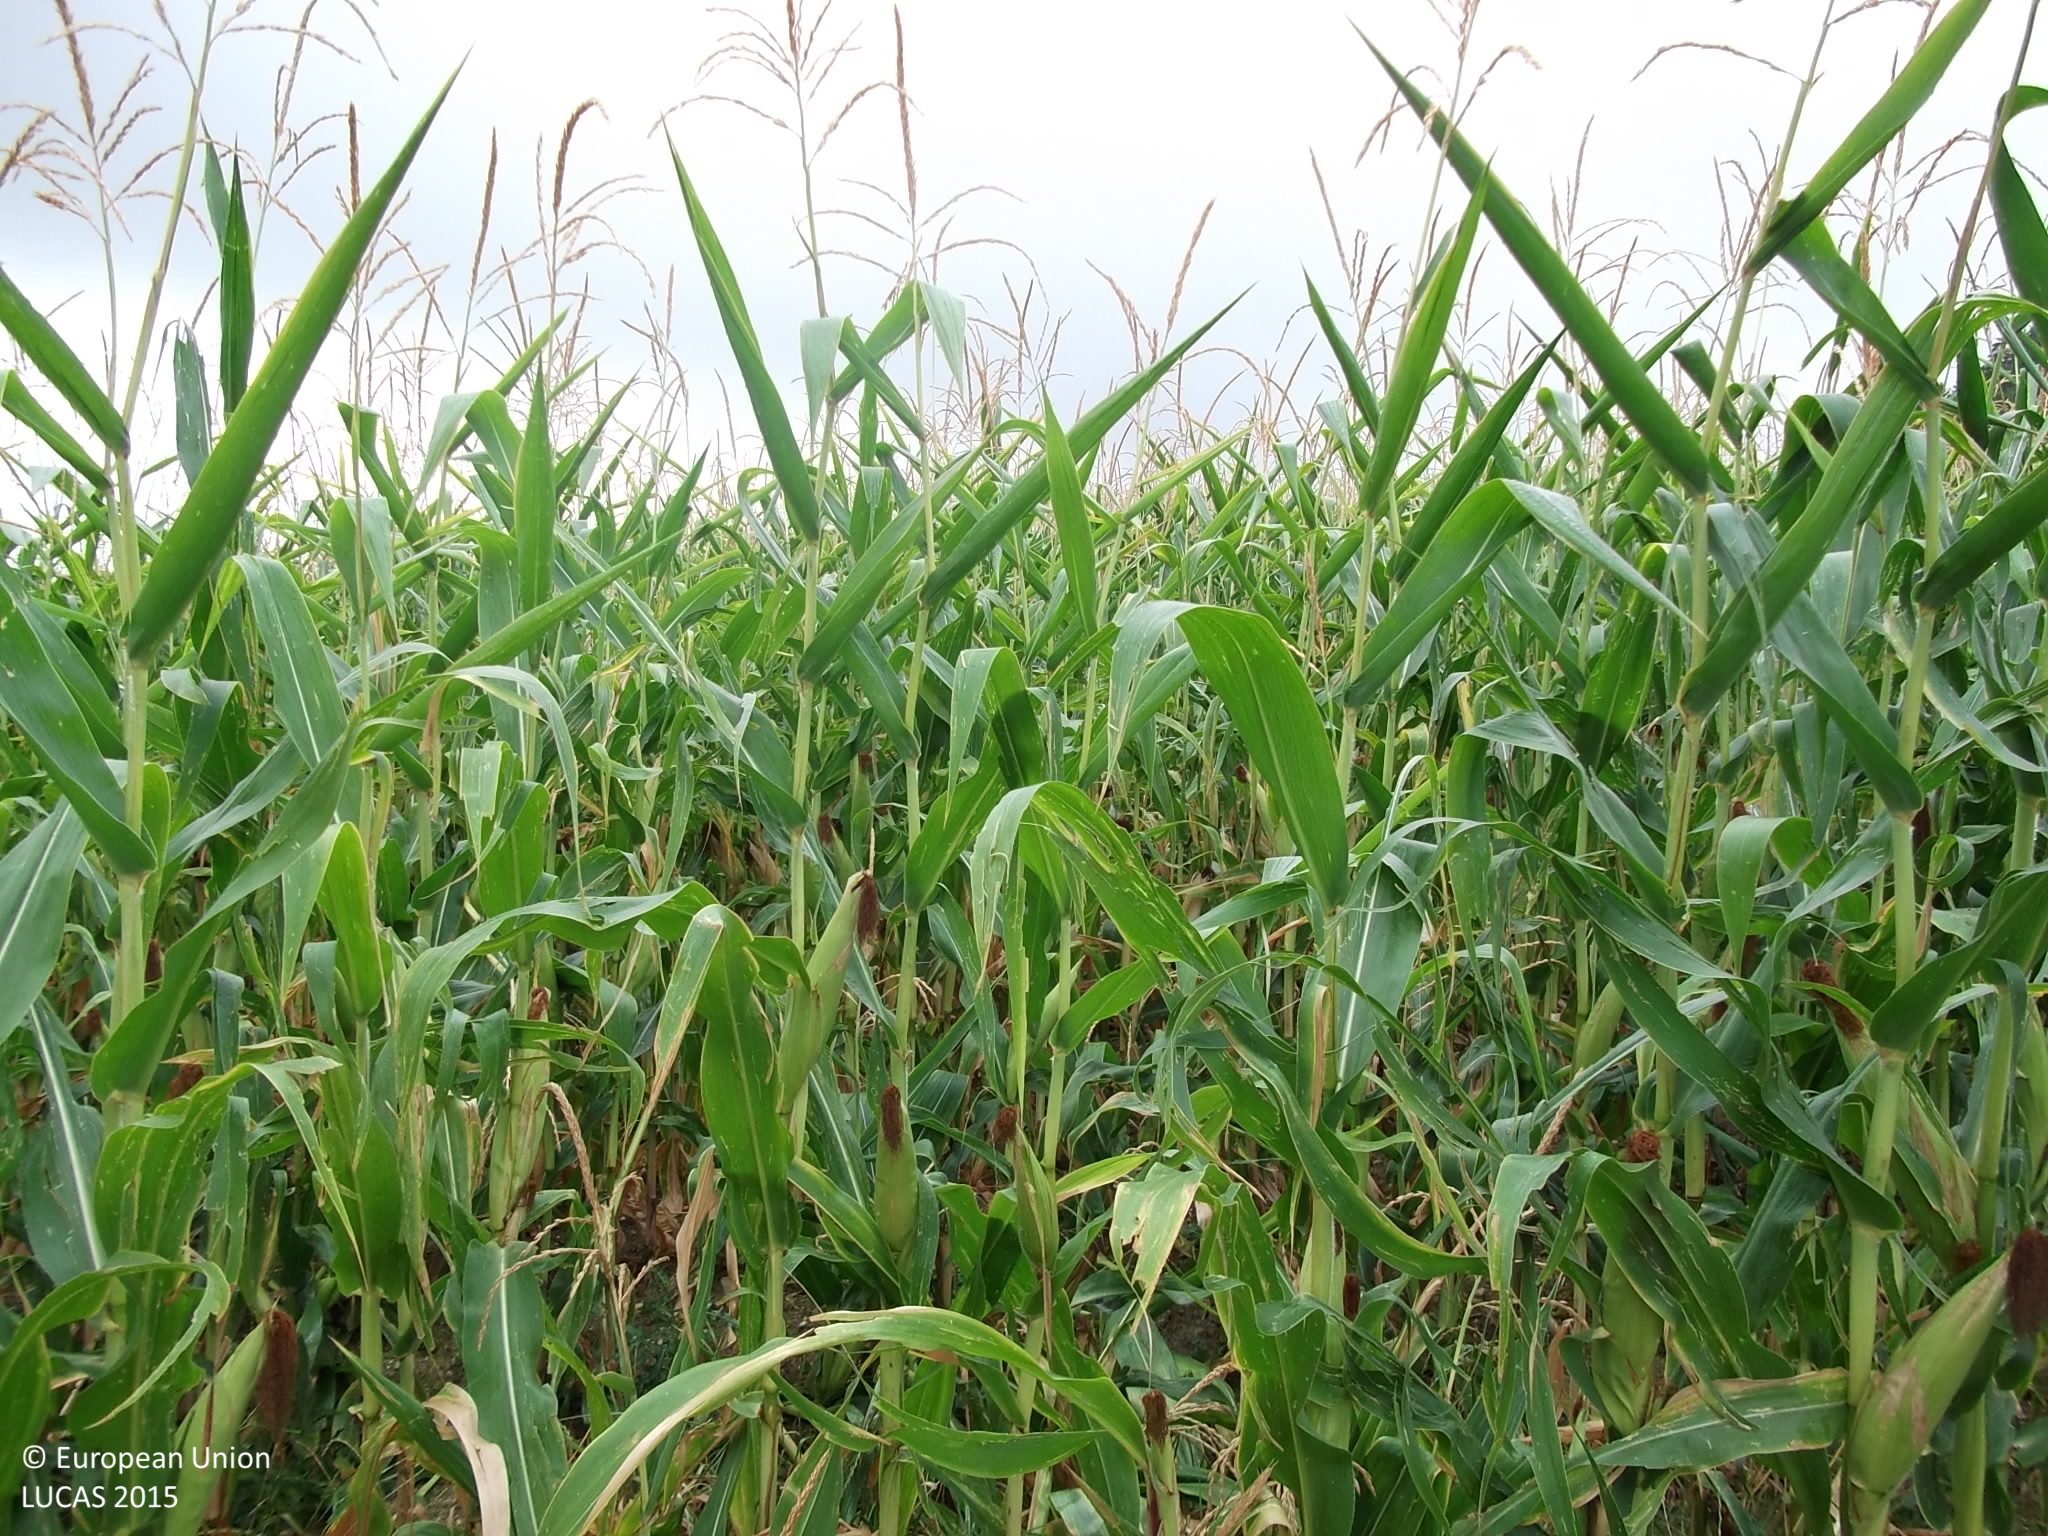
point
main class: Cropland
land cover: Maize
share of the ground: > 75 %
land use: Agriculture (excluding fallow land and kitchen gardens)
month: August
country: AT
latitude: 48.2446
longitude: 13.3523
